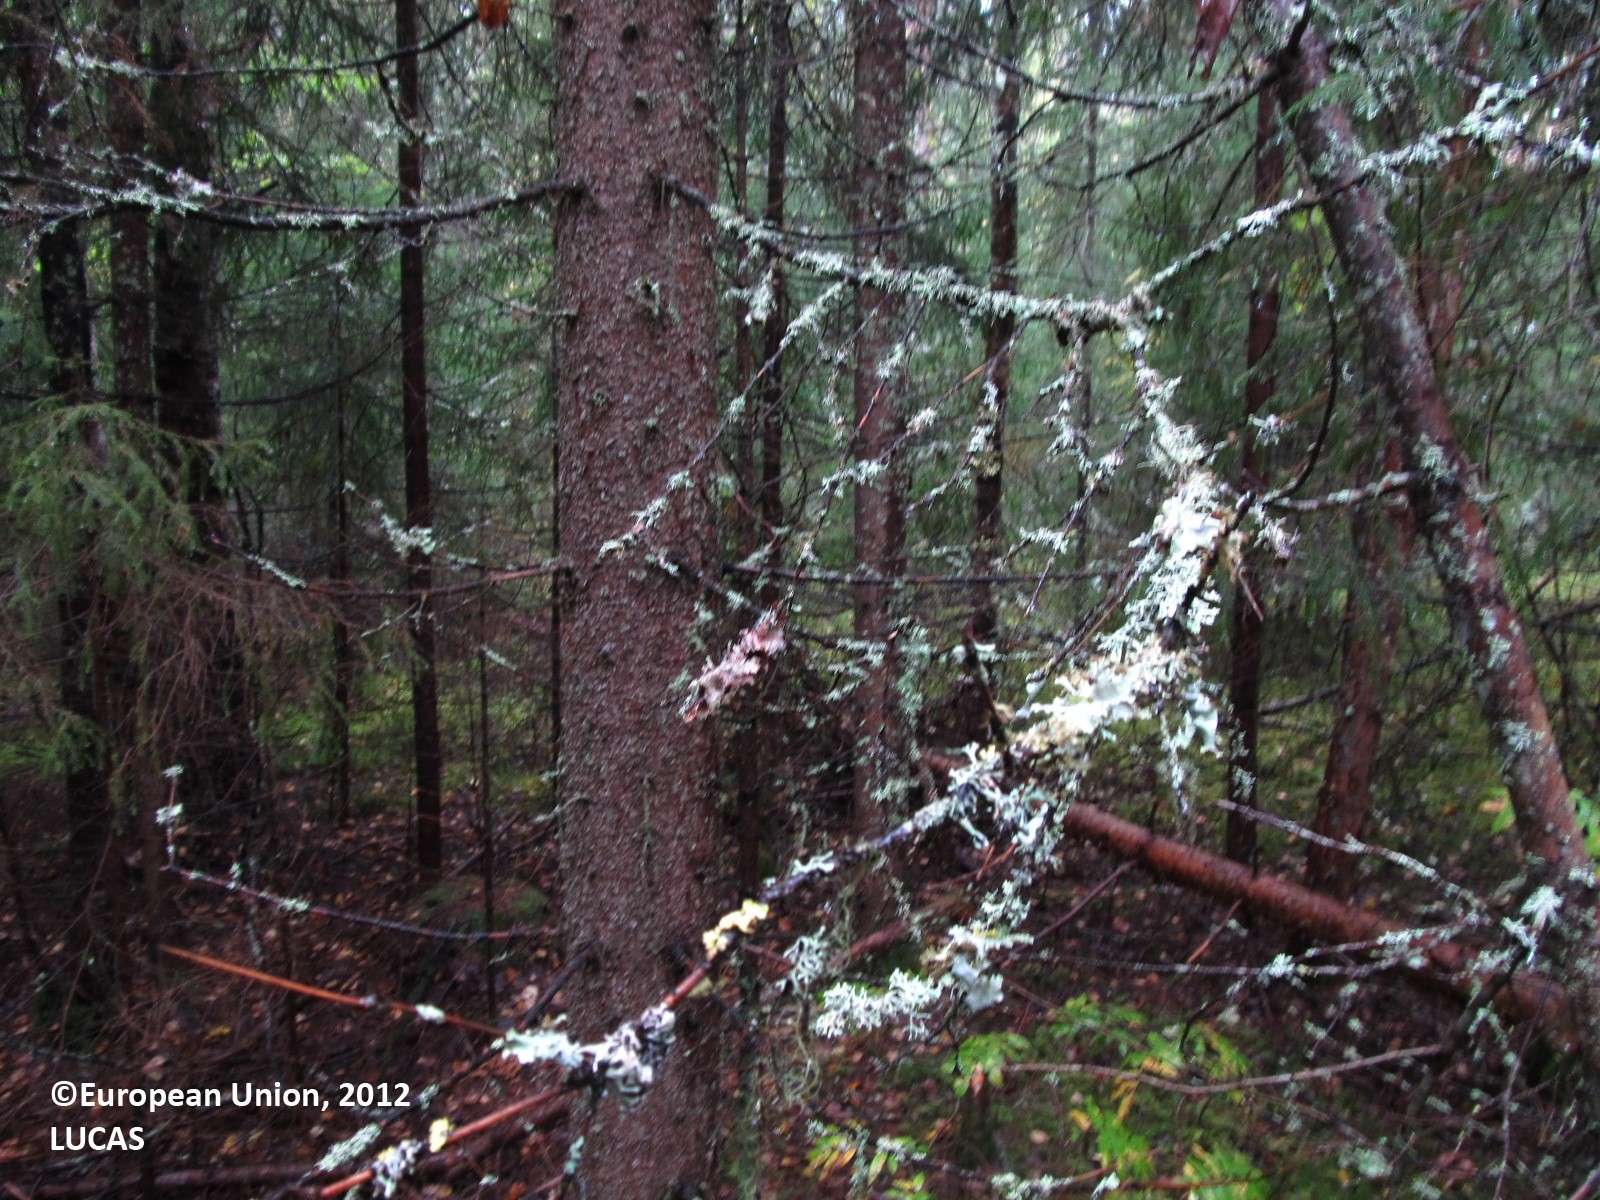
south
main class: Woodland
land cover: Spruce dominated coniferous woodland
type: boreal forest
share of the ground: 50 - 75 %
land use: Forestry
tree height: > 5 m
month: September
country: FI
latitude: 63.1997
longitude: 28.0490
